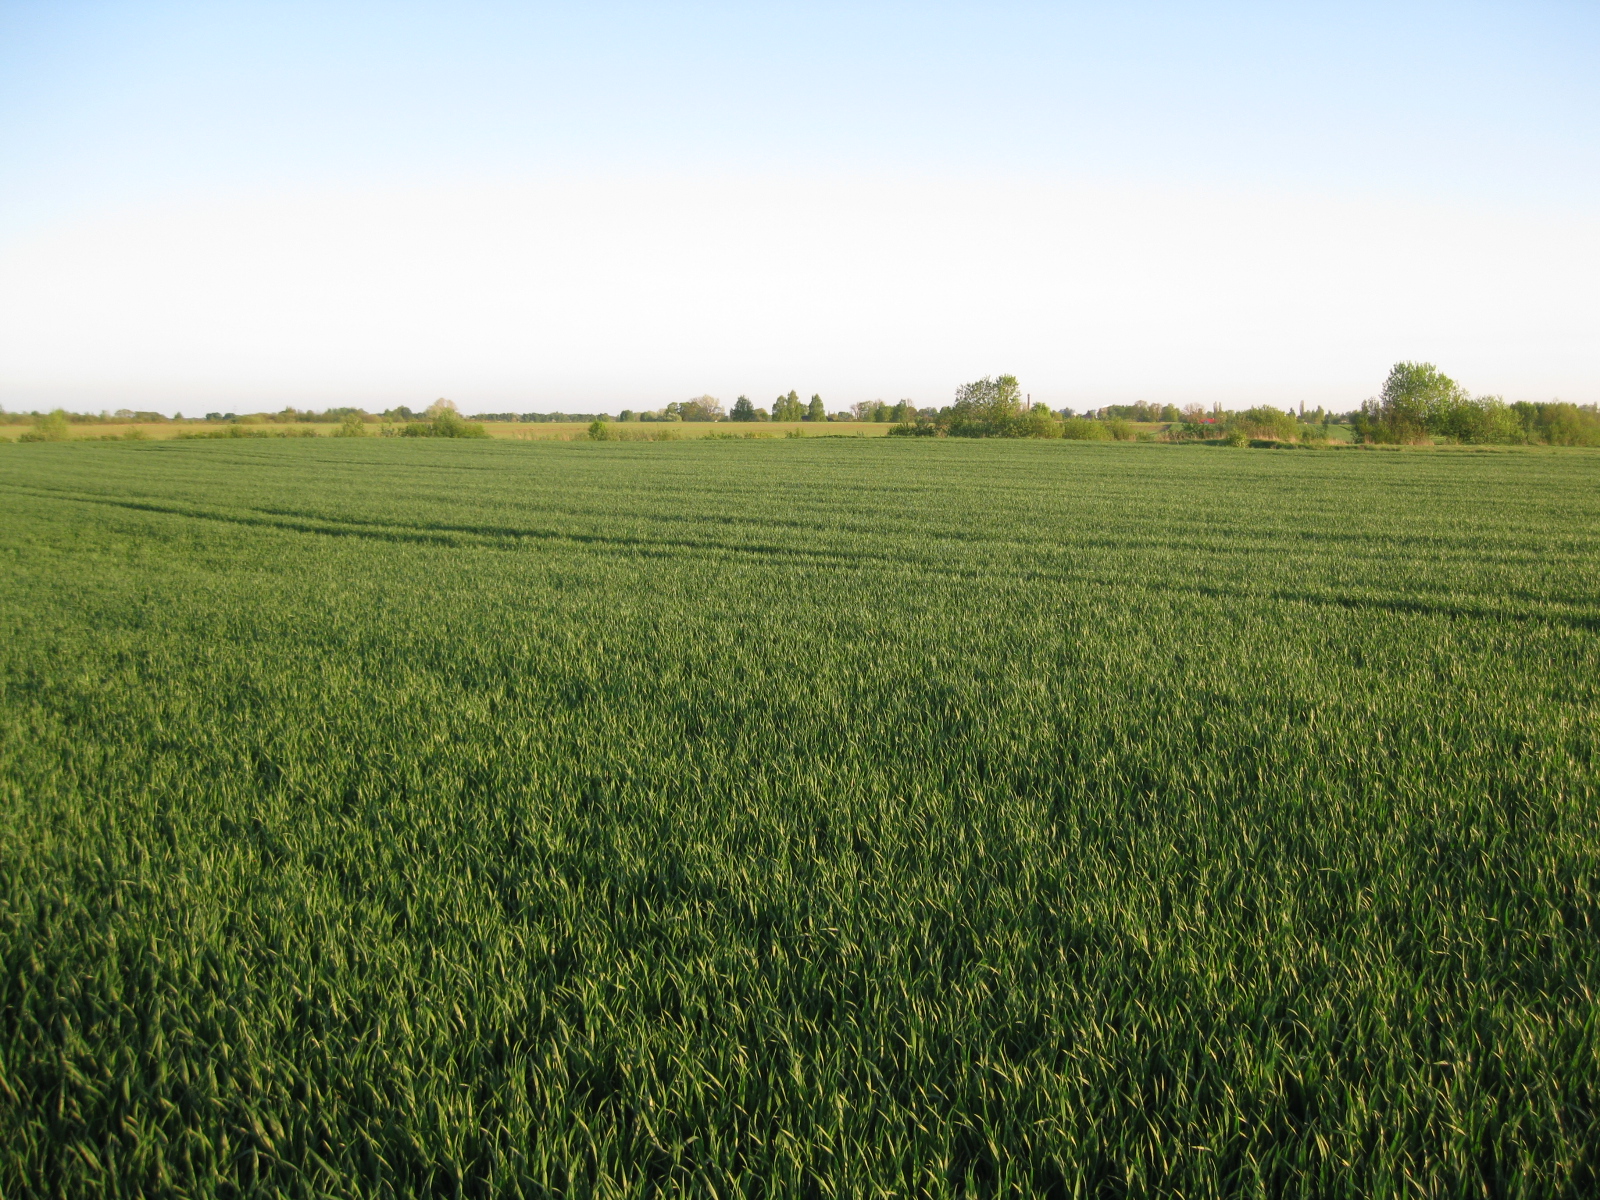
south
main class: Cropland
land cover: Common wheat
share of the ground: > 75 %
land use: Agriculture (excluding fallow land and kitchen gardens)
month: May
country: LT
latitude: 56.0993
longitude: 24.4197
